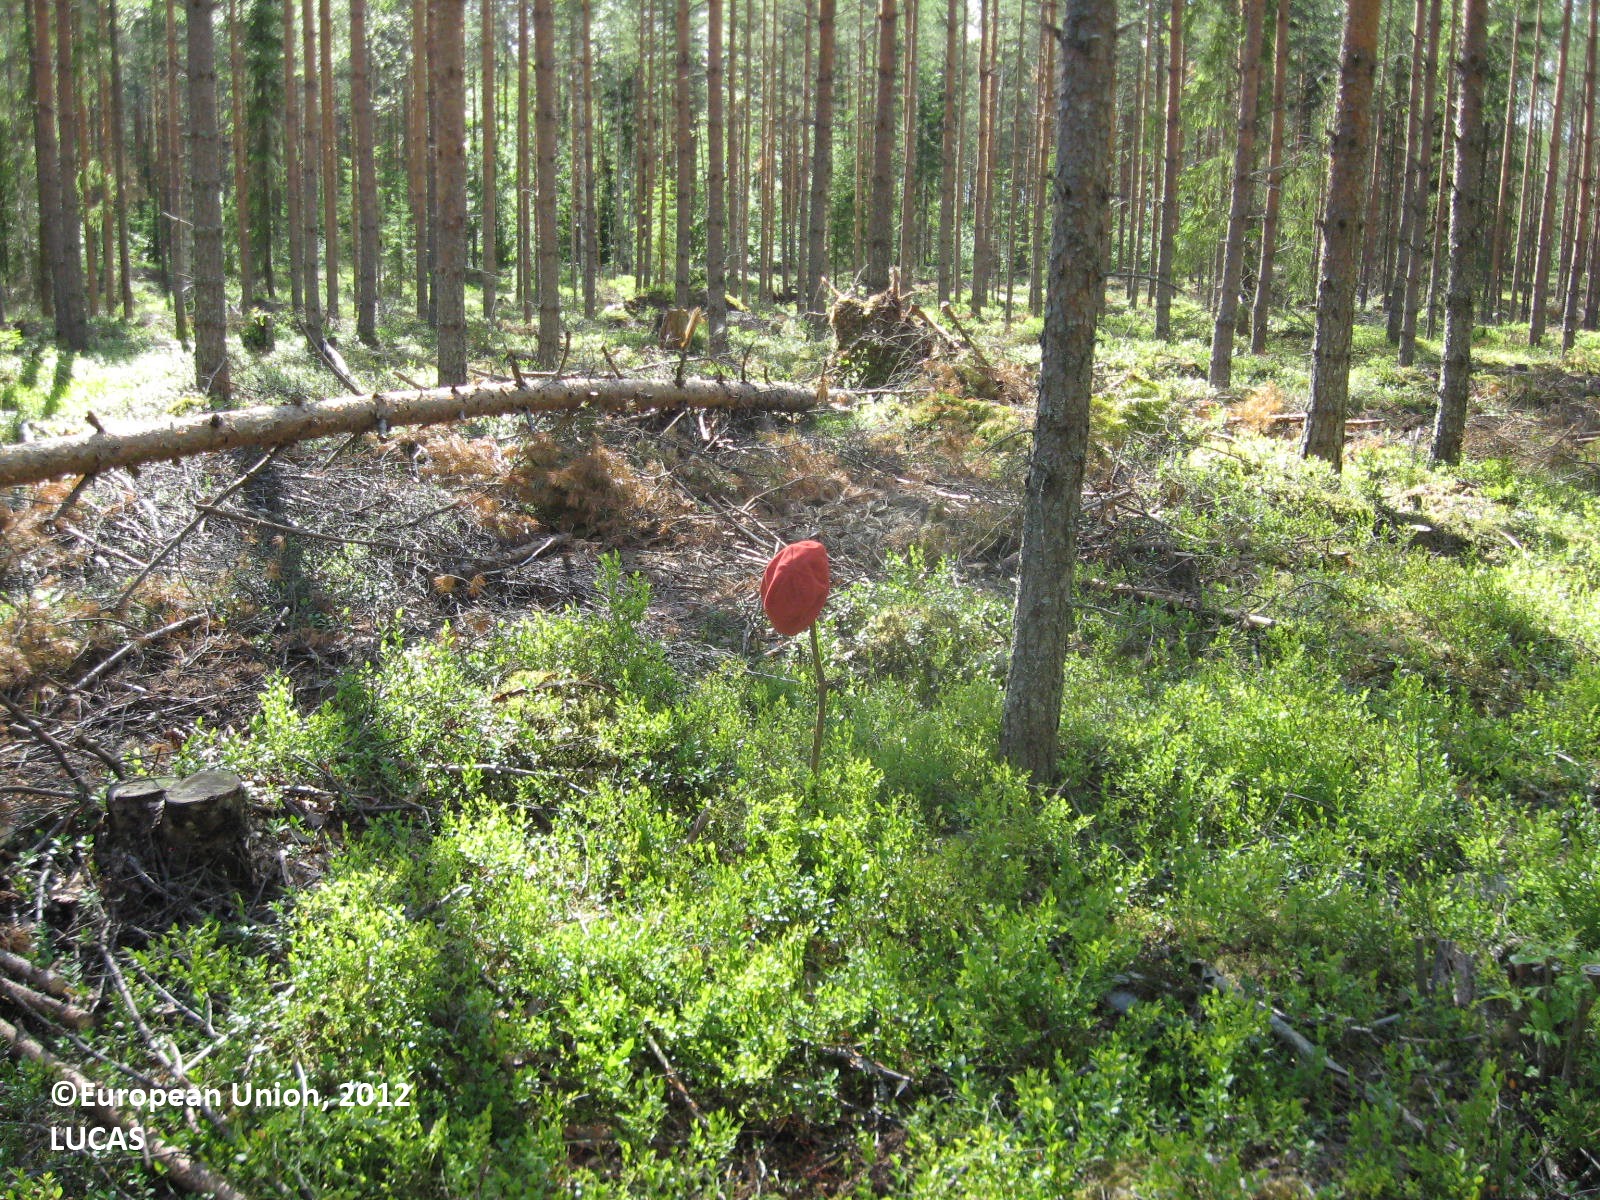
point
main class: Woodland
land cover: Pine dominated coniferous woodland
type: boreal forest
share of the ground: > 75 %
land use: Forestry
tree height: > 5 m
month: June
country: FI
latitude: 62.8183
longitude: 22.7520
